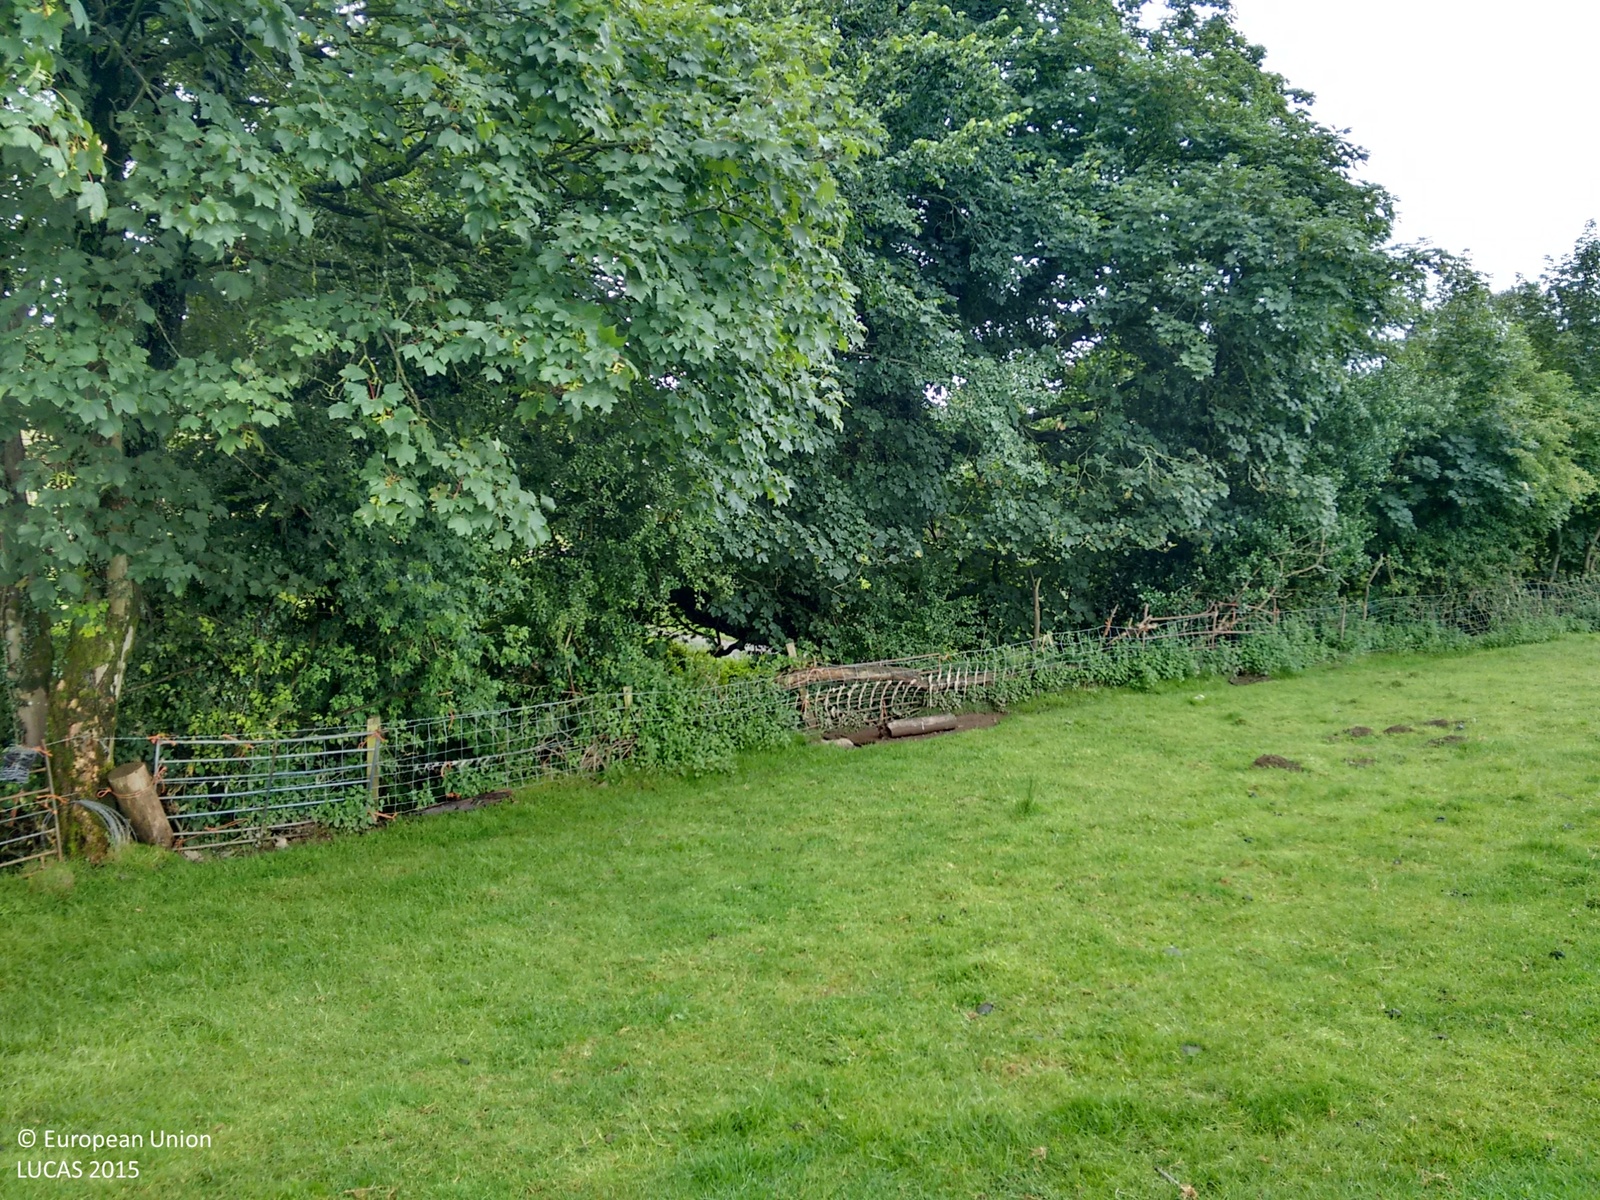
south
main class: Grassland
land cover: Grassland without tree/shrub cover
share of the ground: > 75 %
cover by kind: herbaceous plants 100 %
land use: Agriculture (excluding fallow land and kitchen gardens)
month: July
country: GB
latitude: 51.7133
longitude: -3.9444
